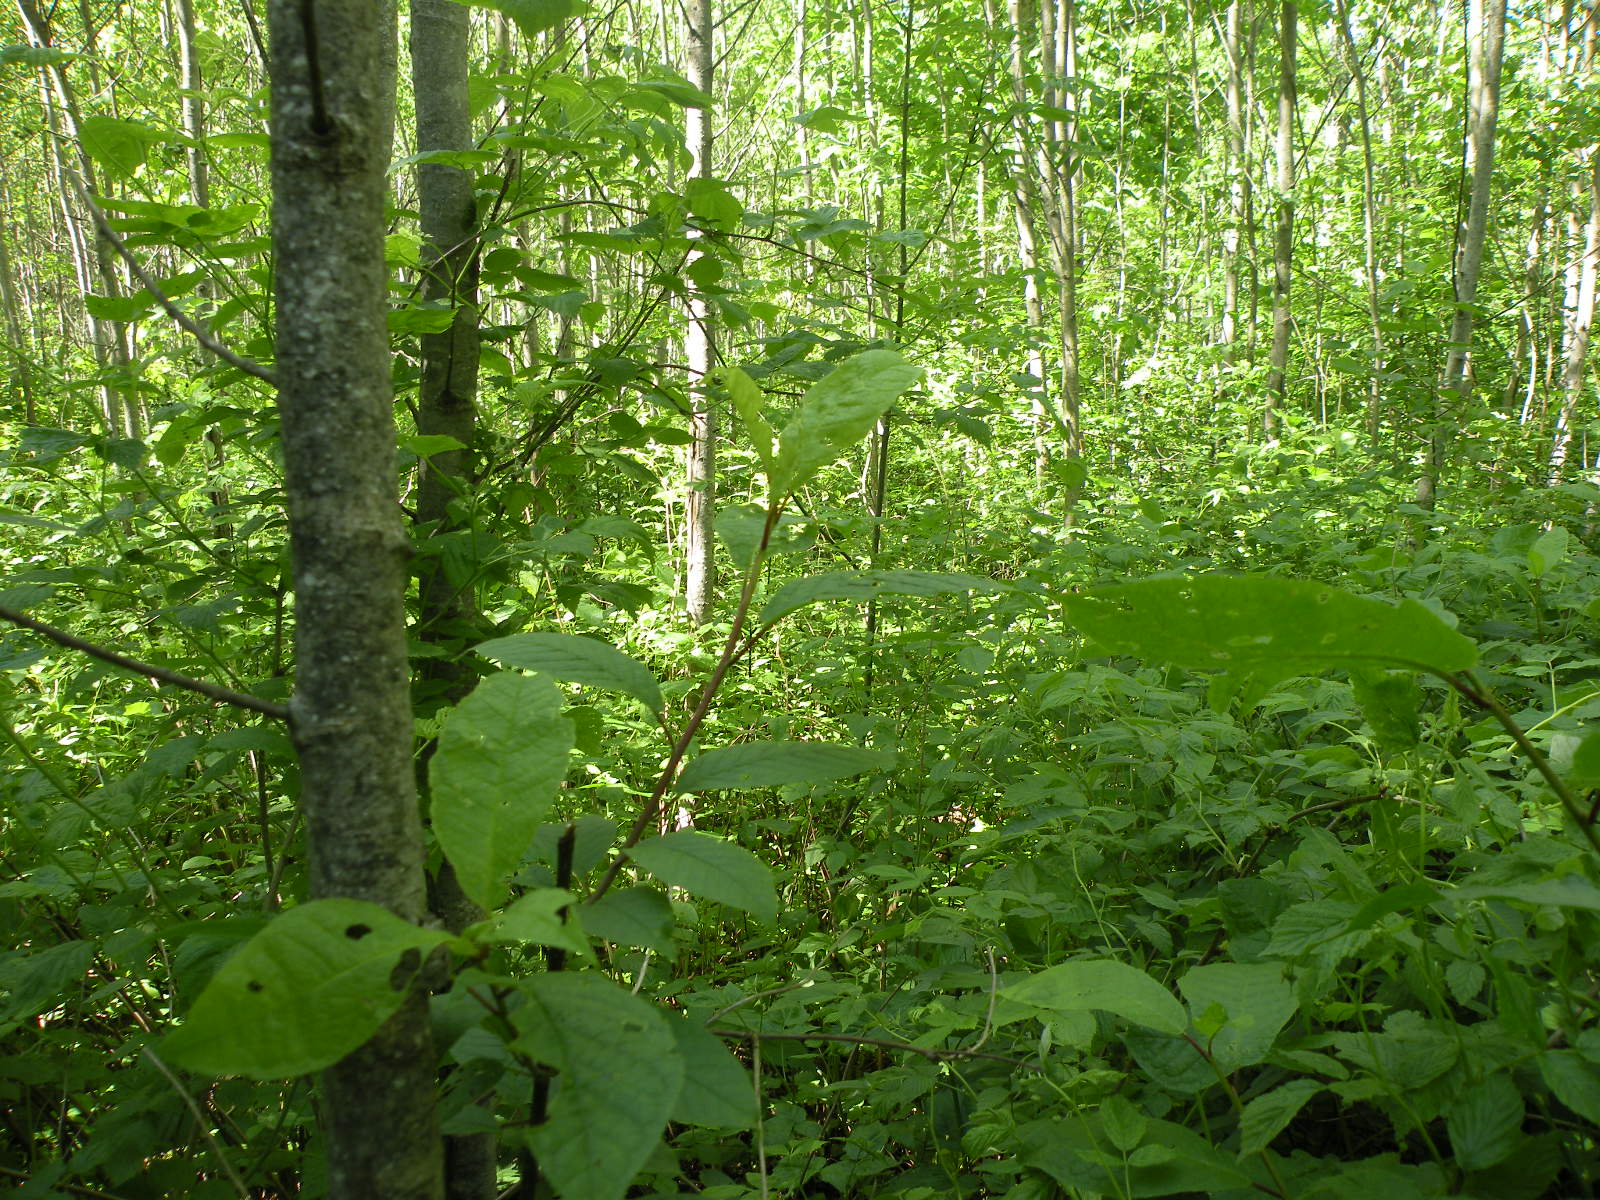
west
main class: Woodland
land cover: Broadleaved woodland
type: non-riverine alder, birch or aspen forest
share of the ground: > 75 %
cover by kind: broadleaved forest trees 85 %, herbaceous plants 10 %, shrubs 5 %
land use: Forestry
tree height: > 5 m
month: May
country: LV
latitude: 55.9950
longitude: 26.1899
